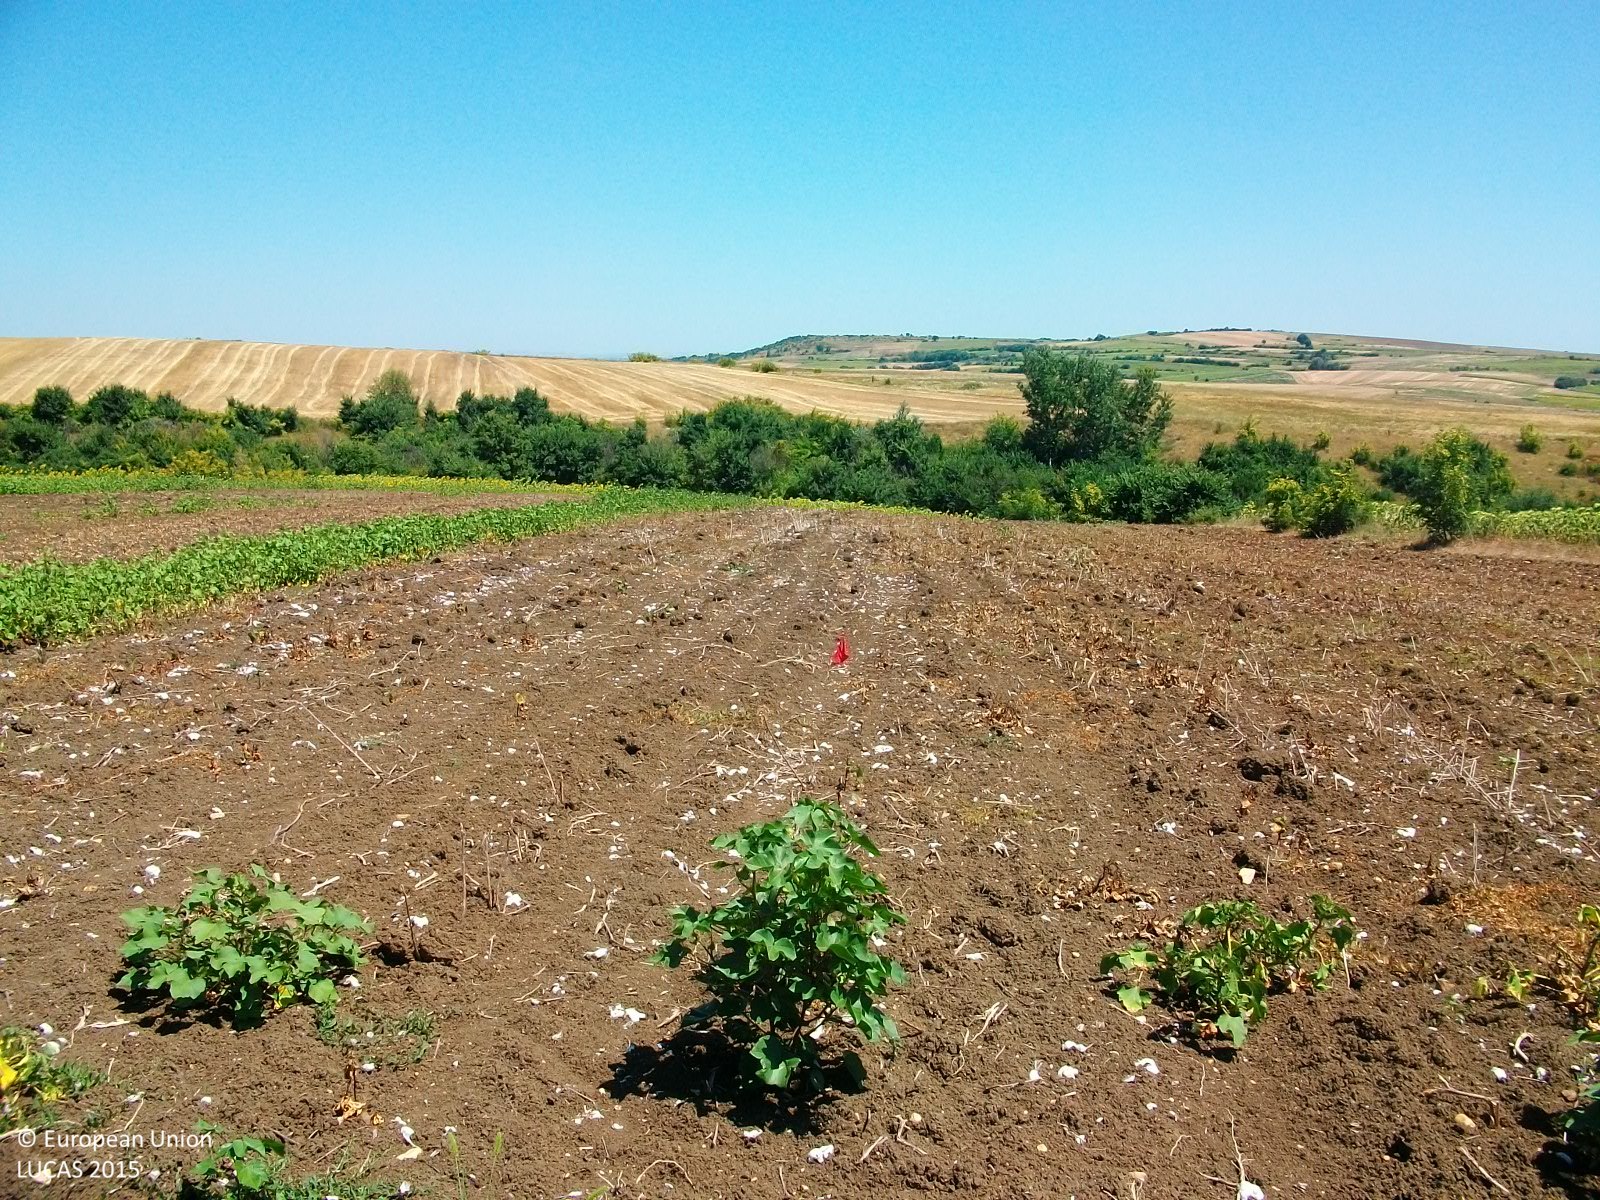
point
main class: Cropland
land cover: Cotton
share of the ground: > 75 %
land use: Agriculture (excluding fallow land and kitchen gardens)
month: July
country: GR
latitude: 41.5487
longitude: 26.2707
